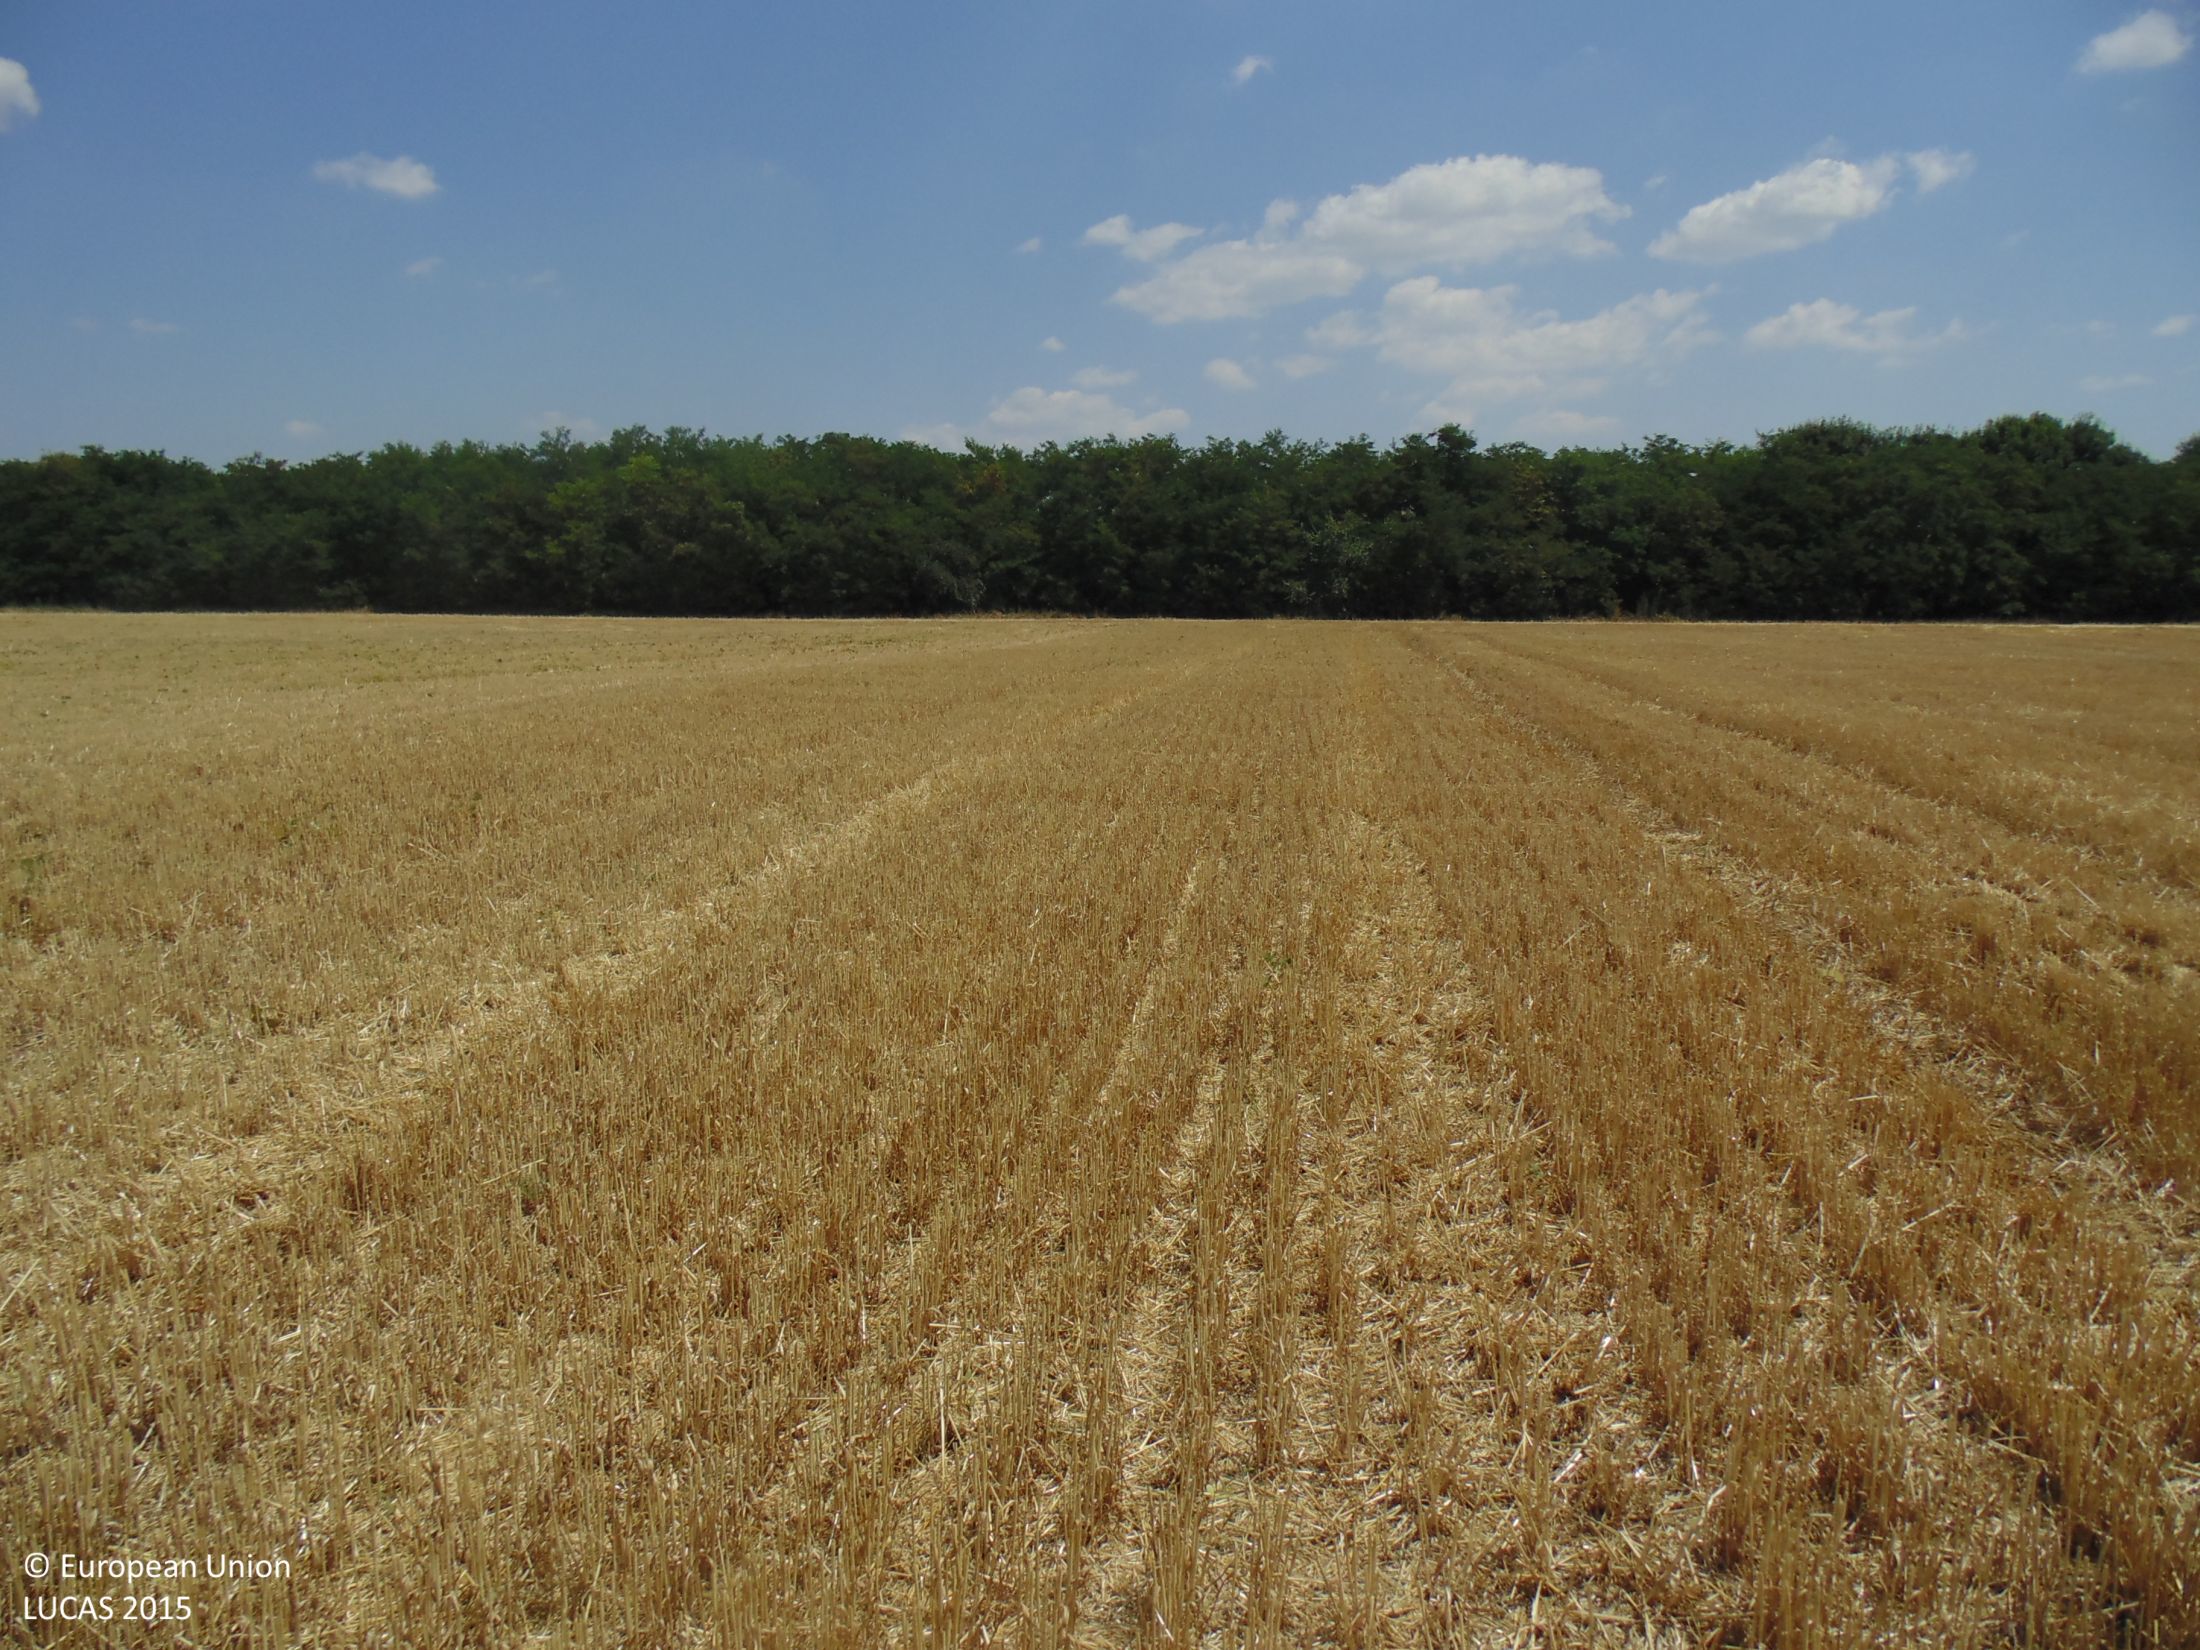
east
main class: Cropland
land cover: Common wheat
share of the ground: > 75 %
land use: Agriculture (excluding fallow land and kitchen gardens)
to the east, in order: Common wheat; Grass margins; Tracks; Broadleaved woodland; Maize
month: July
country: BG
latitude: 43.6861
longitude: 27.6673
